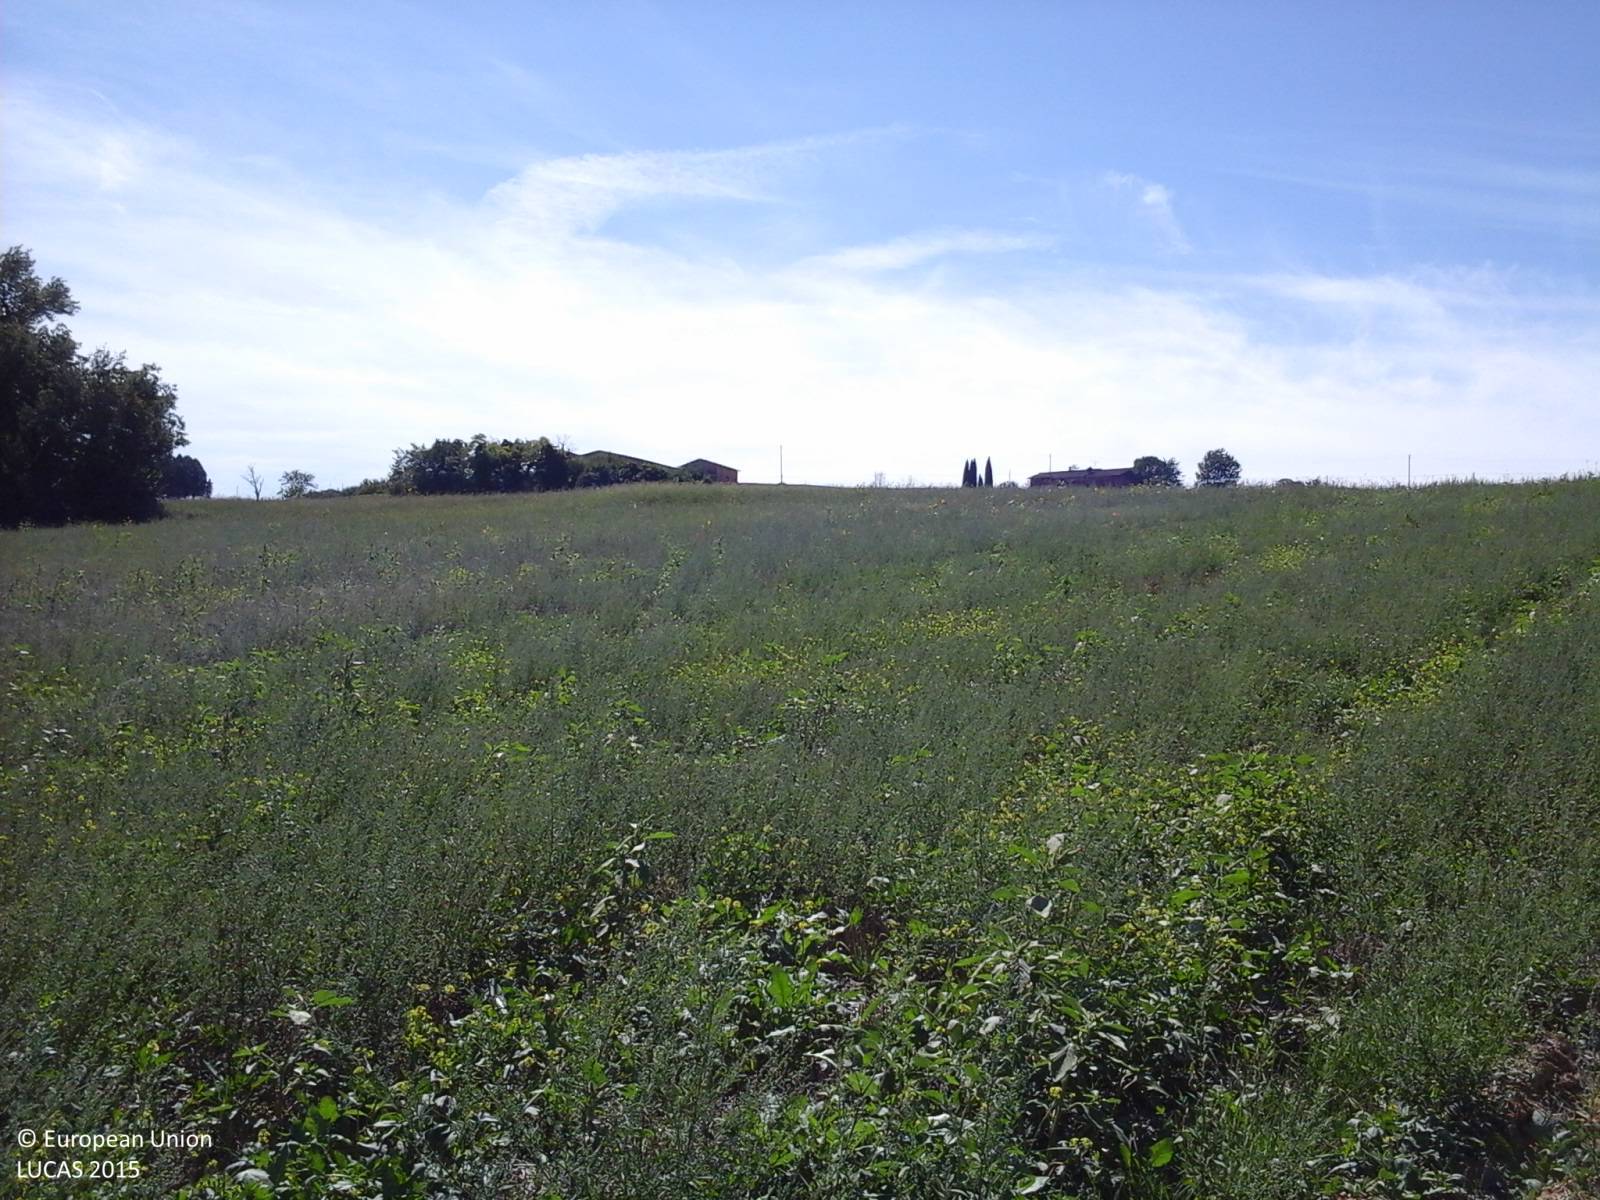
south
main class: Grassland
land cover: Spontaneously vegetated surfaces
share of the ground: > 75 %
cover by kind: herbaceous plants 100 %
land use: Fallow land
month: September
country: IT
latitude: 42.9709
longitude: 12.3104
